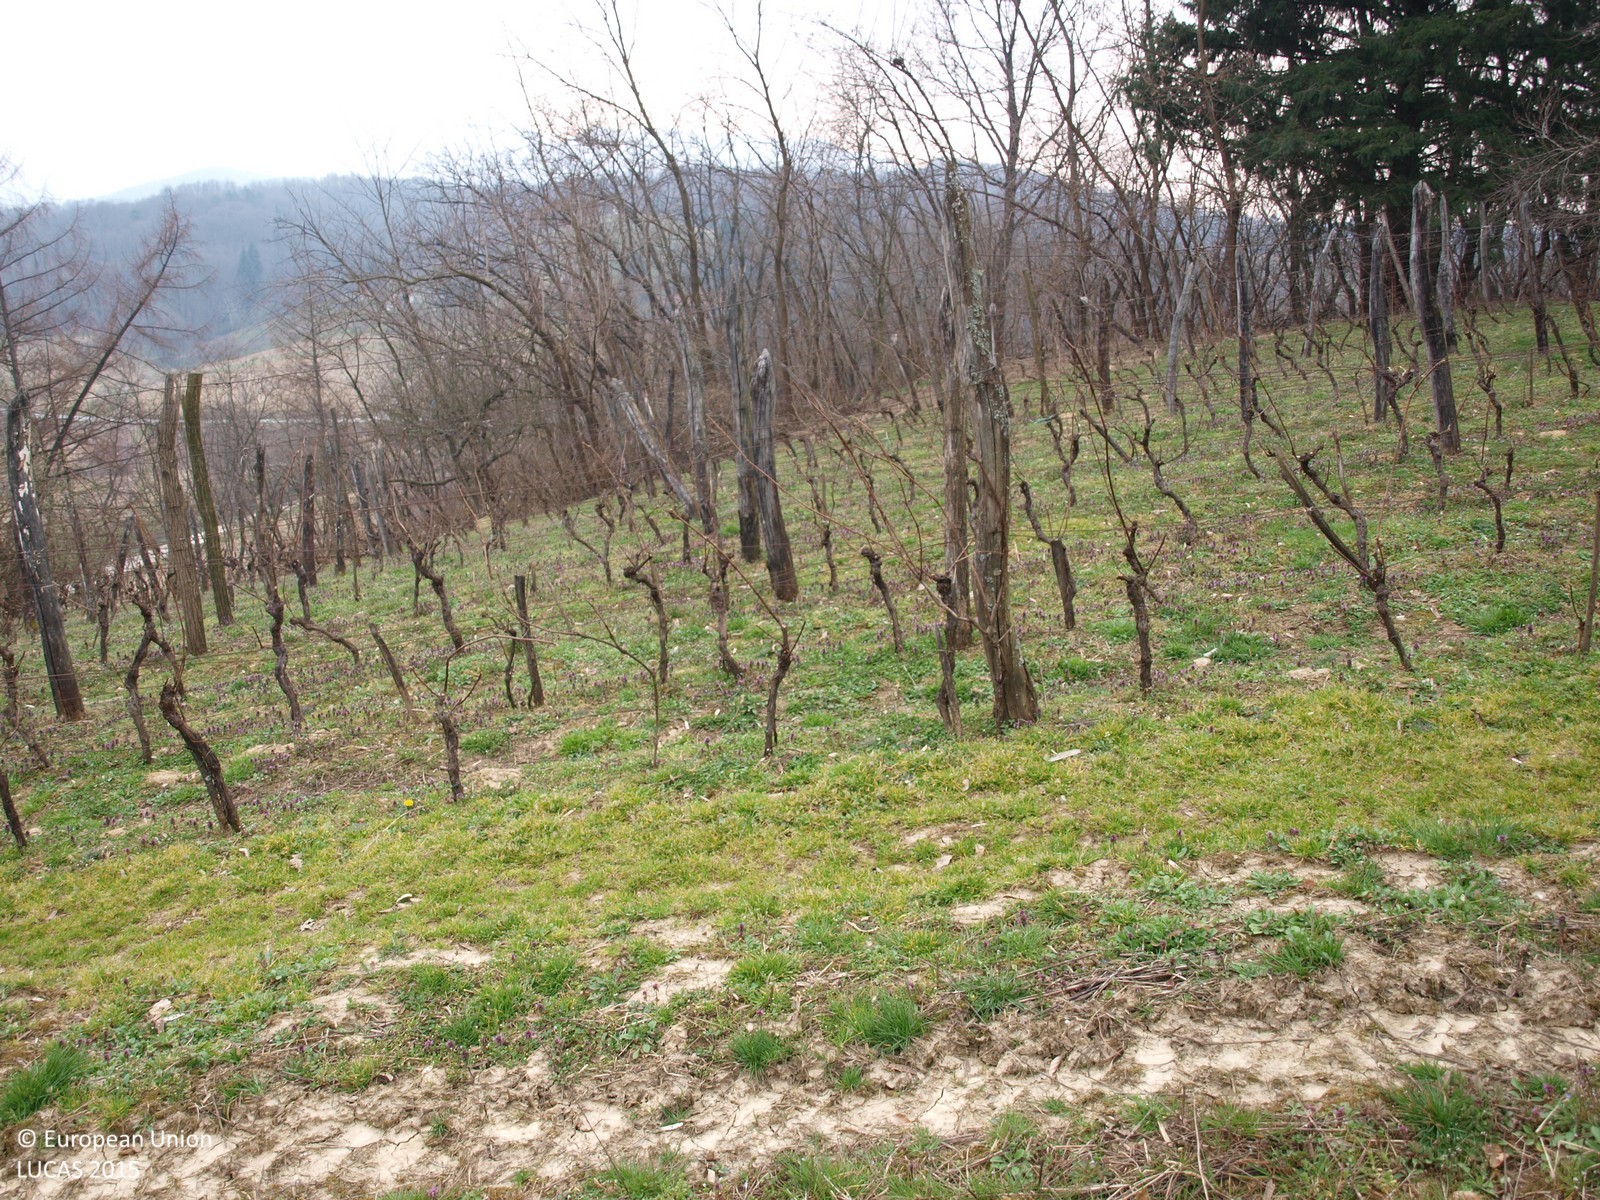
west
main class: Grassland
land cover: Grassland without tree/shrub cover
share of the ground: > 75 %
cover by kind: herbaceous plants 100 %
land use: Agriculture (excluding fallow land and kitchen gardens)
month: March
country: HR
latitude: 46.2264
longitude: 16.1840
